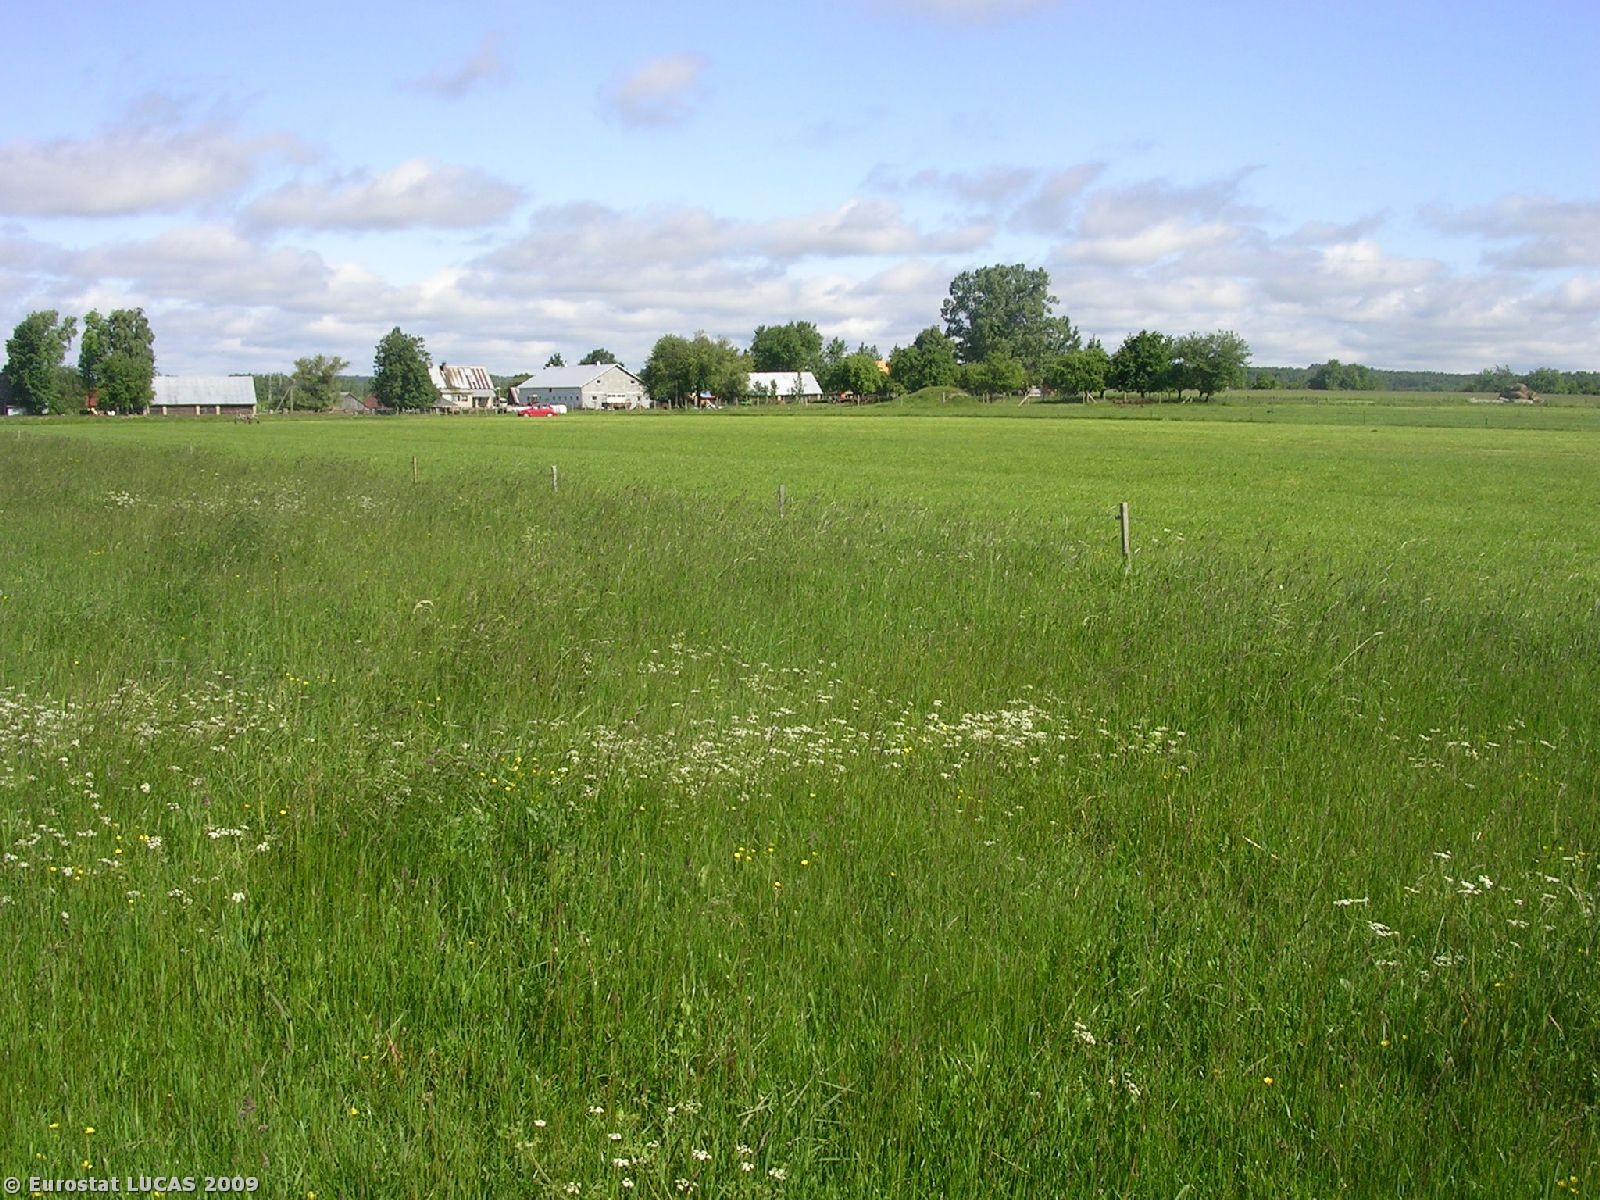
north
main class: Grassland
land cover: Grassland without tree/shrub cover
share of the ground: > 75 %
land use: Agriculture (excluding fallow land and kitchen gardens)
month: August
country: PL
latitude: 53.4207
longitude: 23.7057
